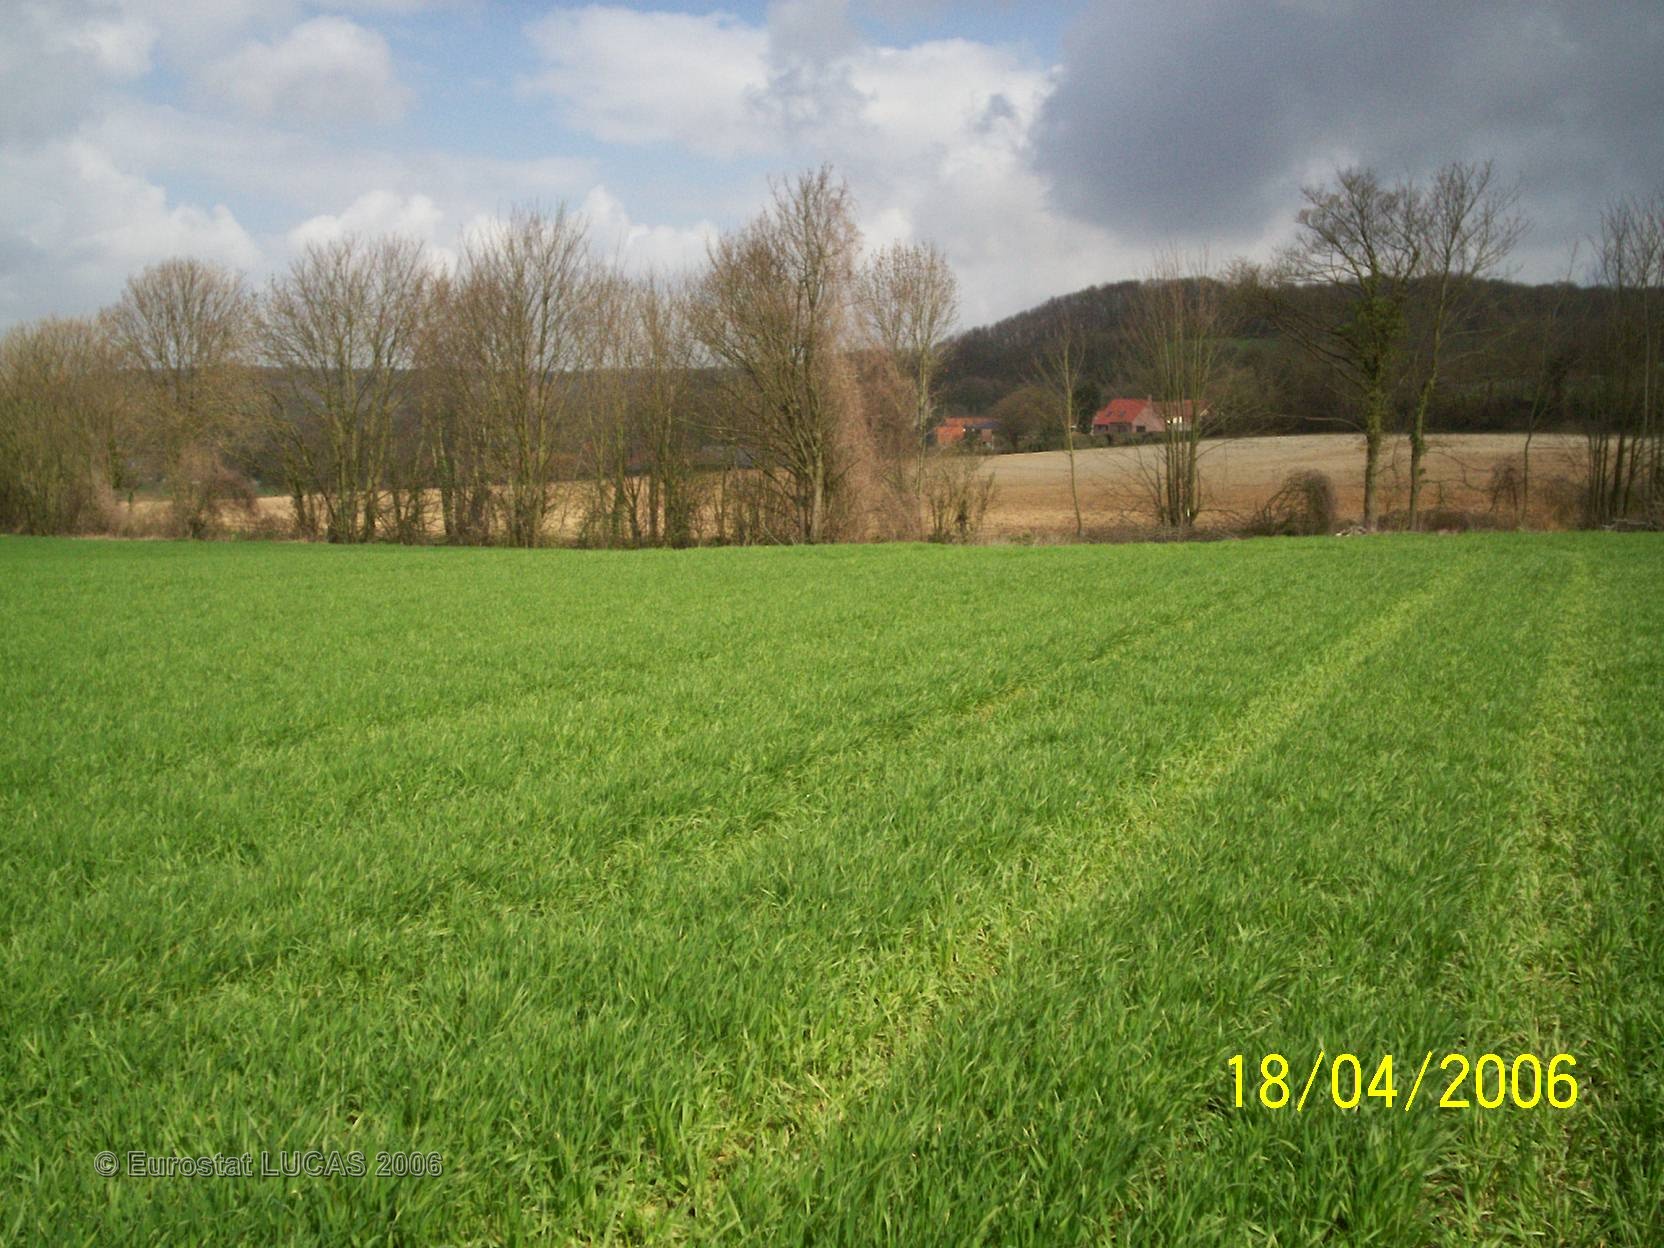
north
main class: Cropland
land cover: Common wheat
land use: Agriculture (excluding fallow land and kitchen gardens)
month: April
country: FR
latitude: 50.4131
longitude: 2.5999
